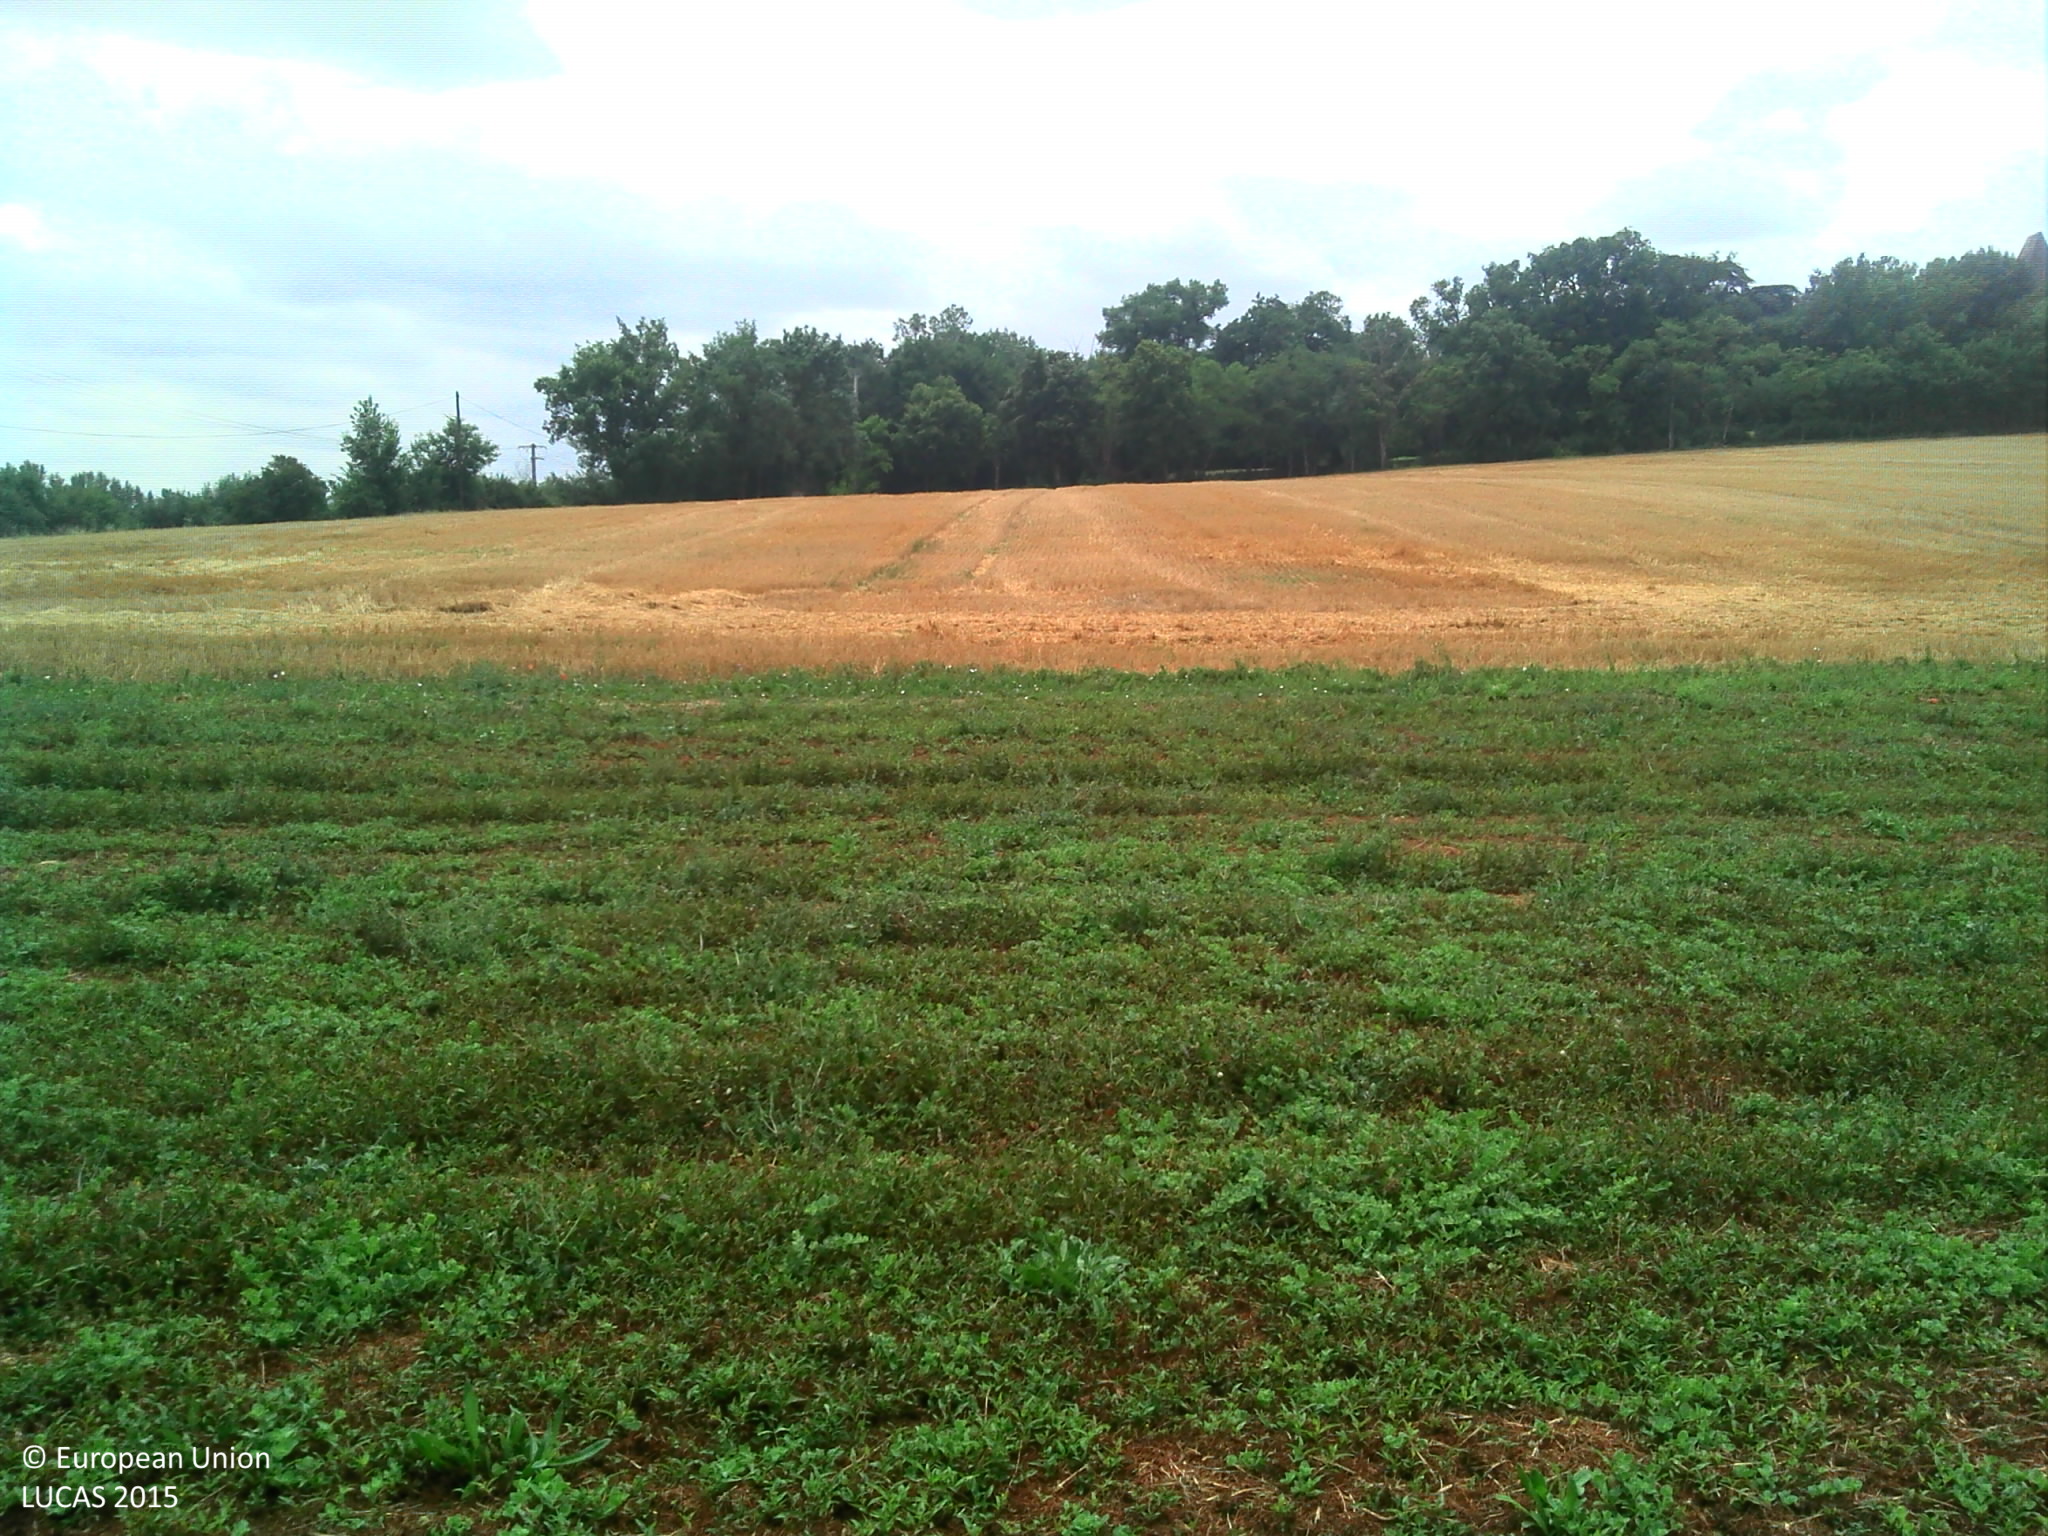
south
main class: Cropland
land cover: Temporary grasslands
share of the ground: > 75 %
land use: Agriculture (excluding fallow land and kitchen gardens)
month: July
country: FR
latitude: 43.8640
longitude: 0.9529
